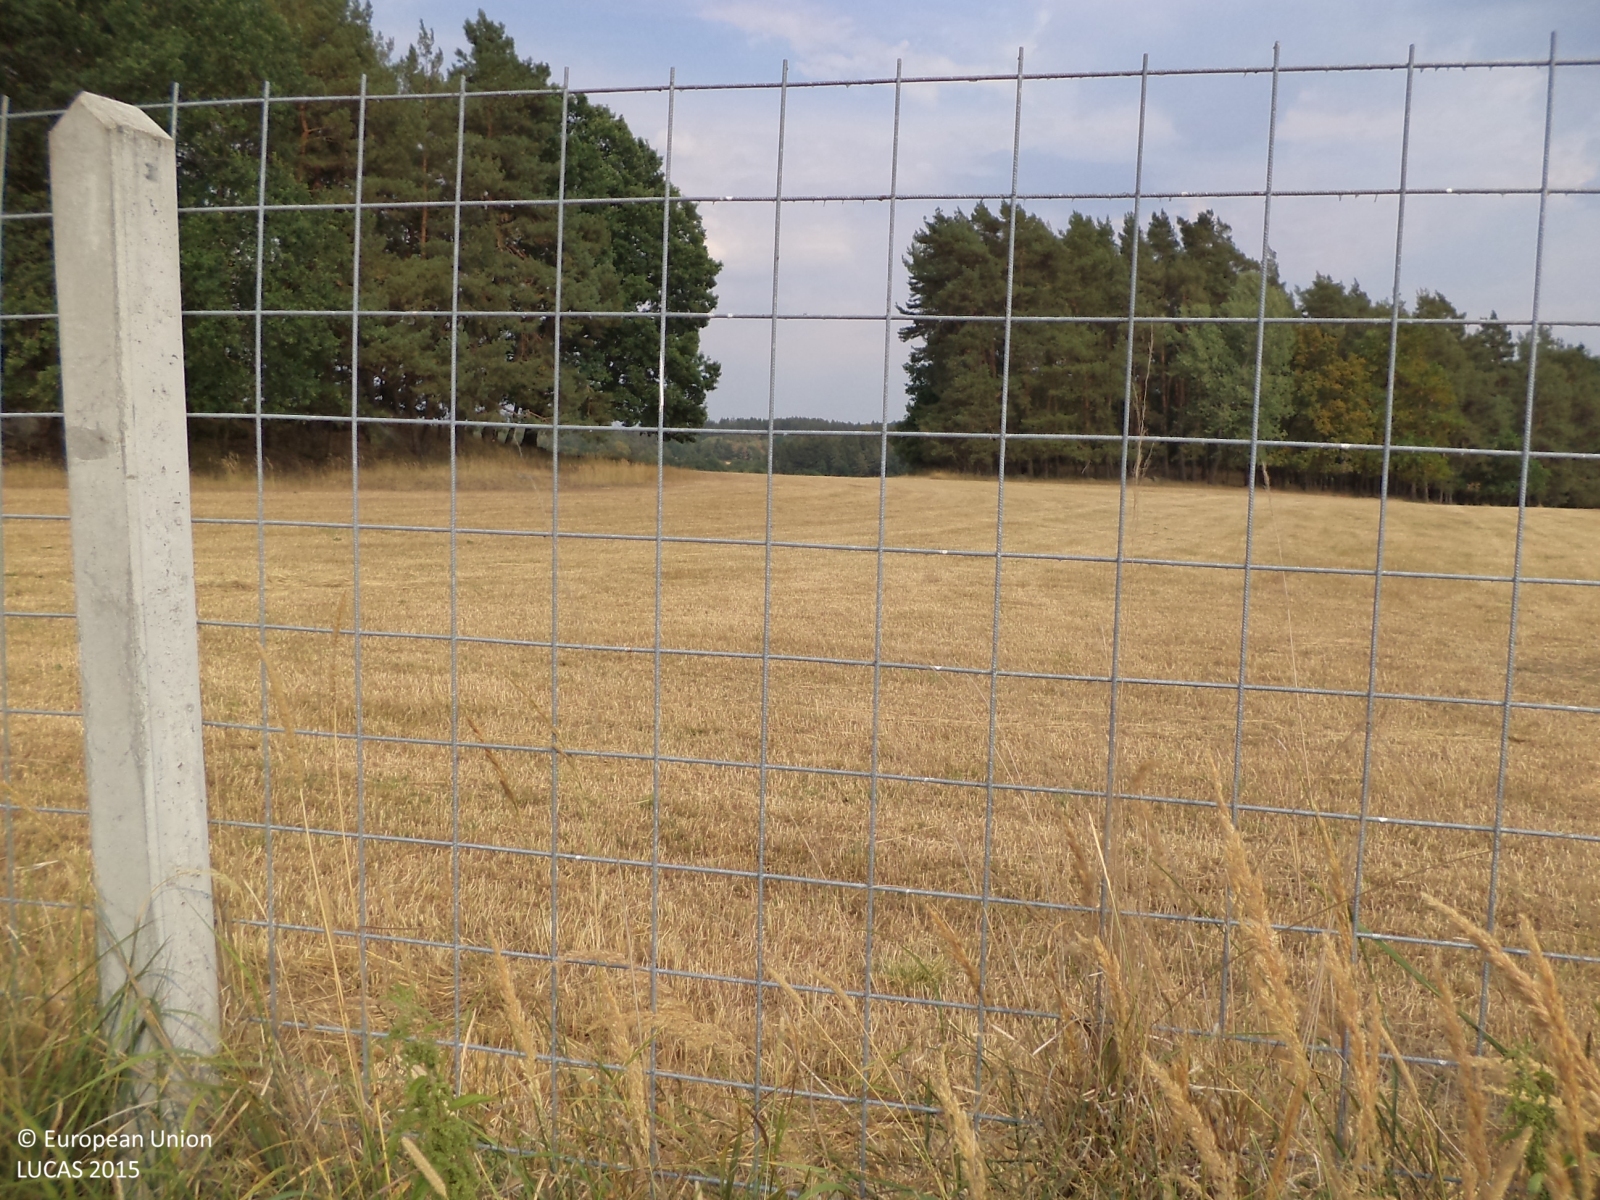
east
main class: Grassland
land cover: Grassland without tree/shrub cover
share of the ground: > 75 %
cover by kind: herbaceous plants 100 %
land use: Agriculture (excluding fallow land and kitchen gardens)
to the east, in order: Grassland without tree/shrub cover
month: August
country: CZ
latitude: 49.5090
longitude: 14.2962
